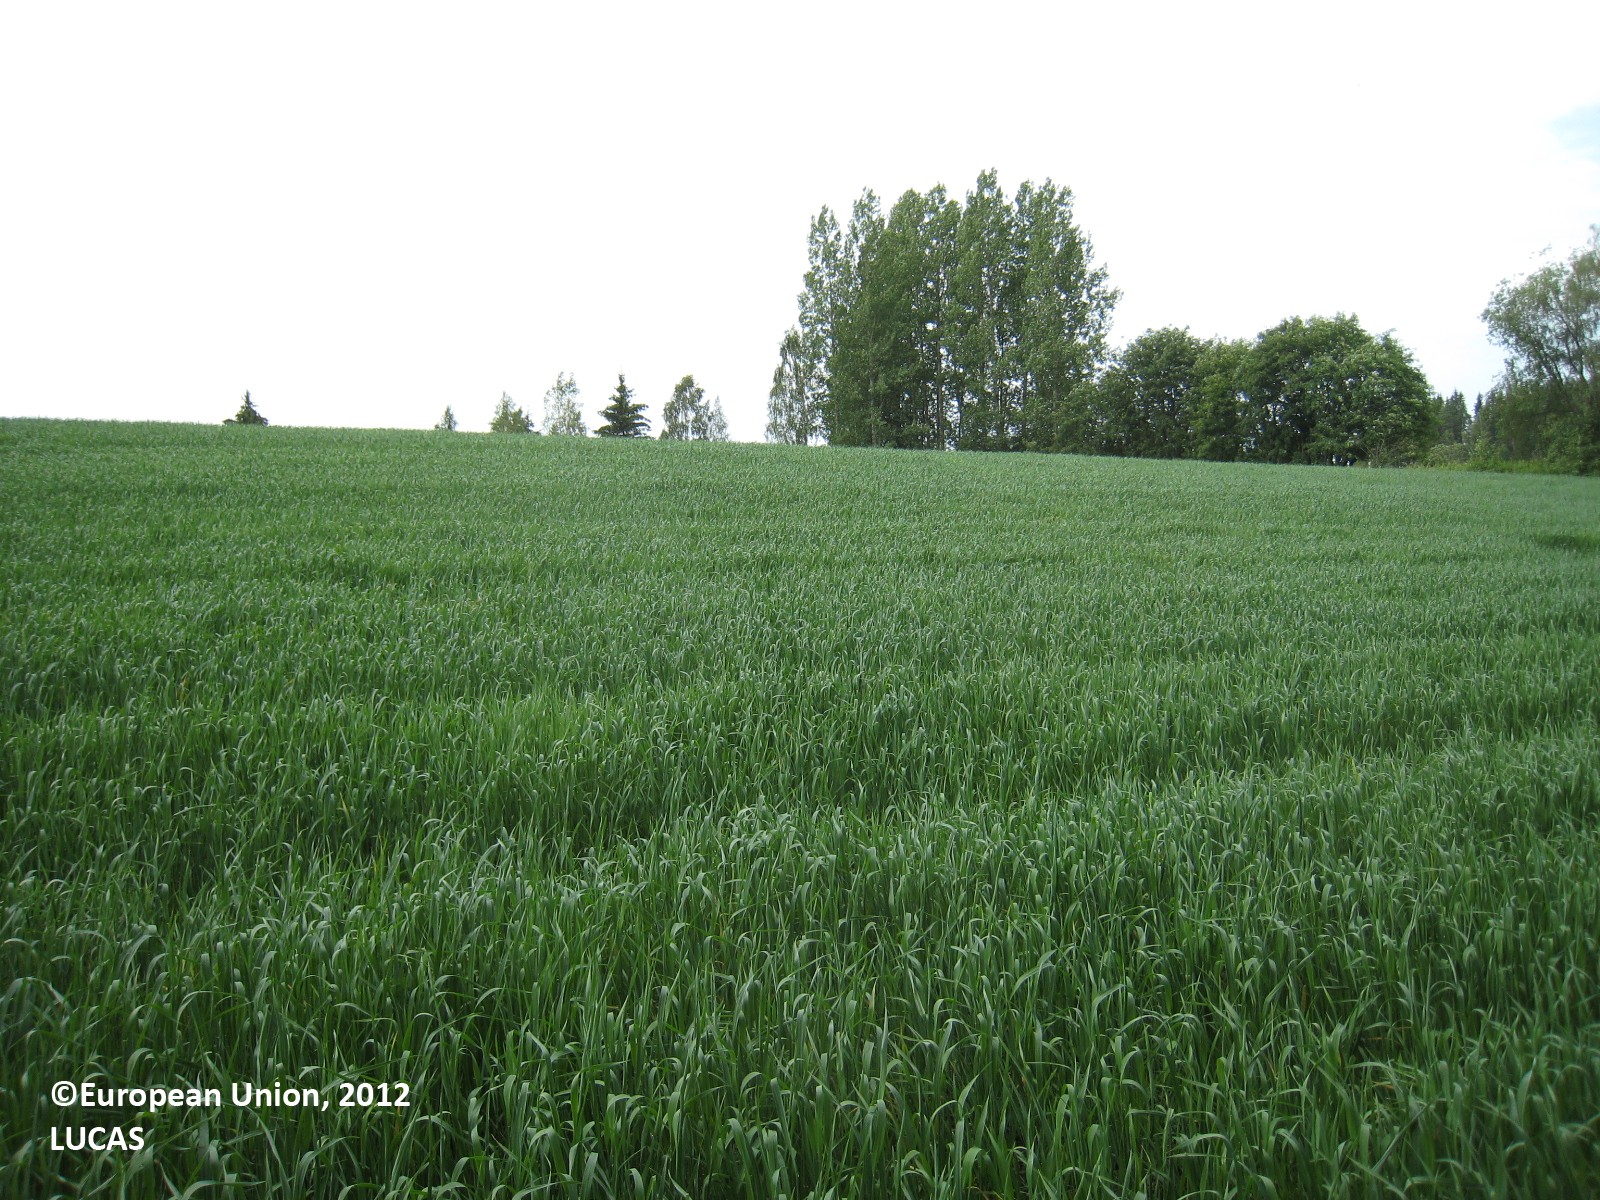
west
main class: Woodland
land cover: Other mixed woodland
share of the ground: > 75 %
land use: Semi-natural and natural areas not in use
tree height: > 5 m
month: July
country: FI
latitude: 61.8677
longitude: 27.0614
